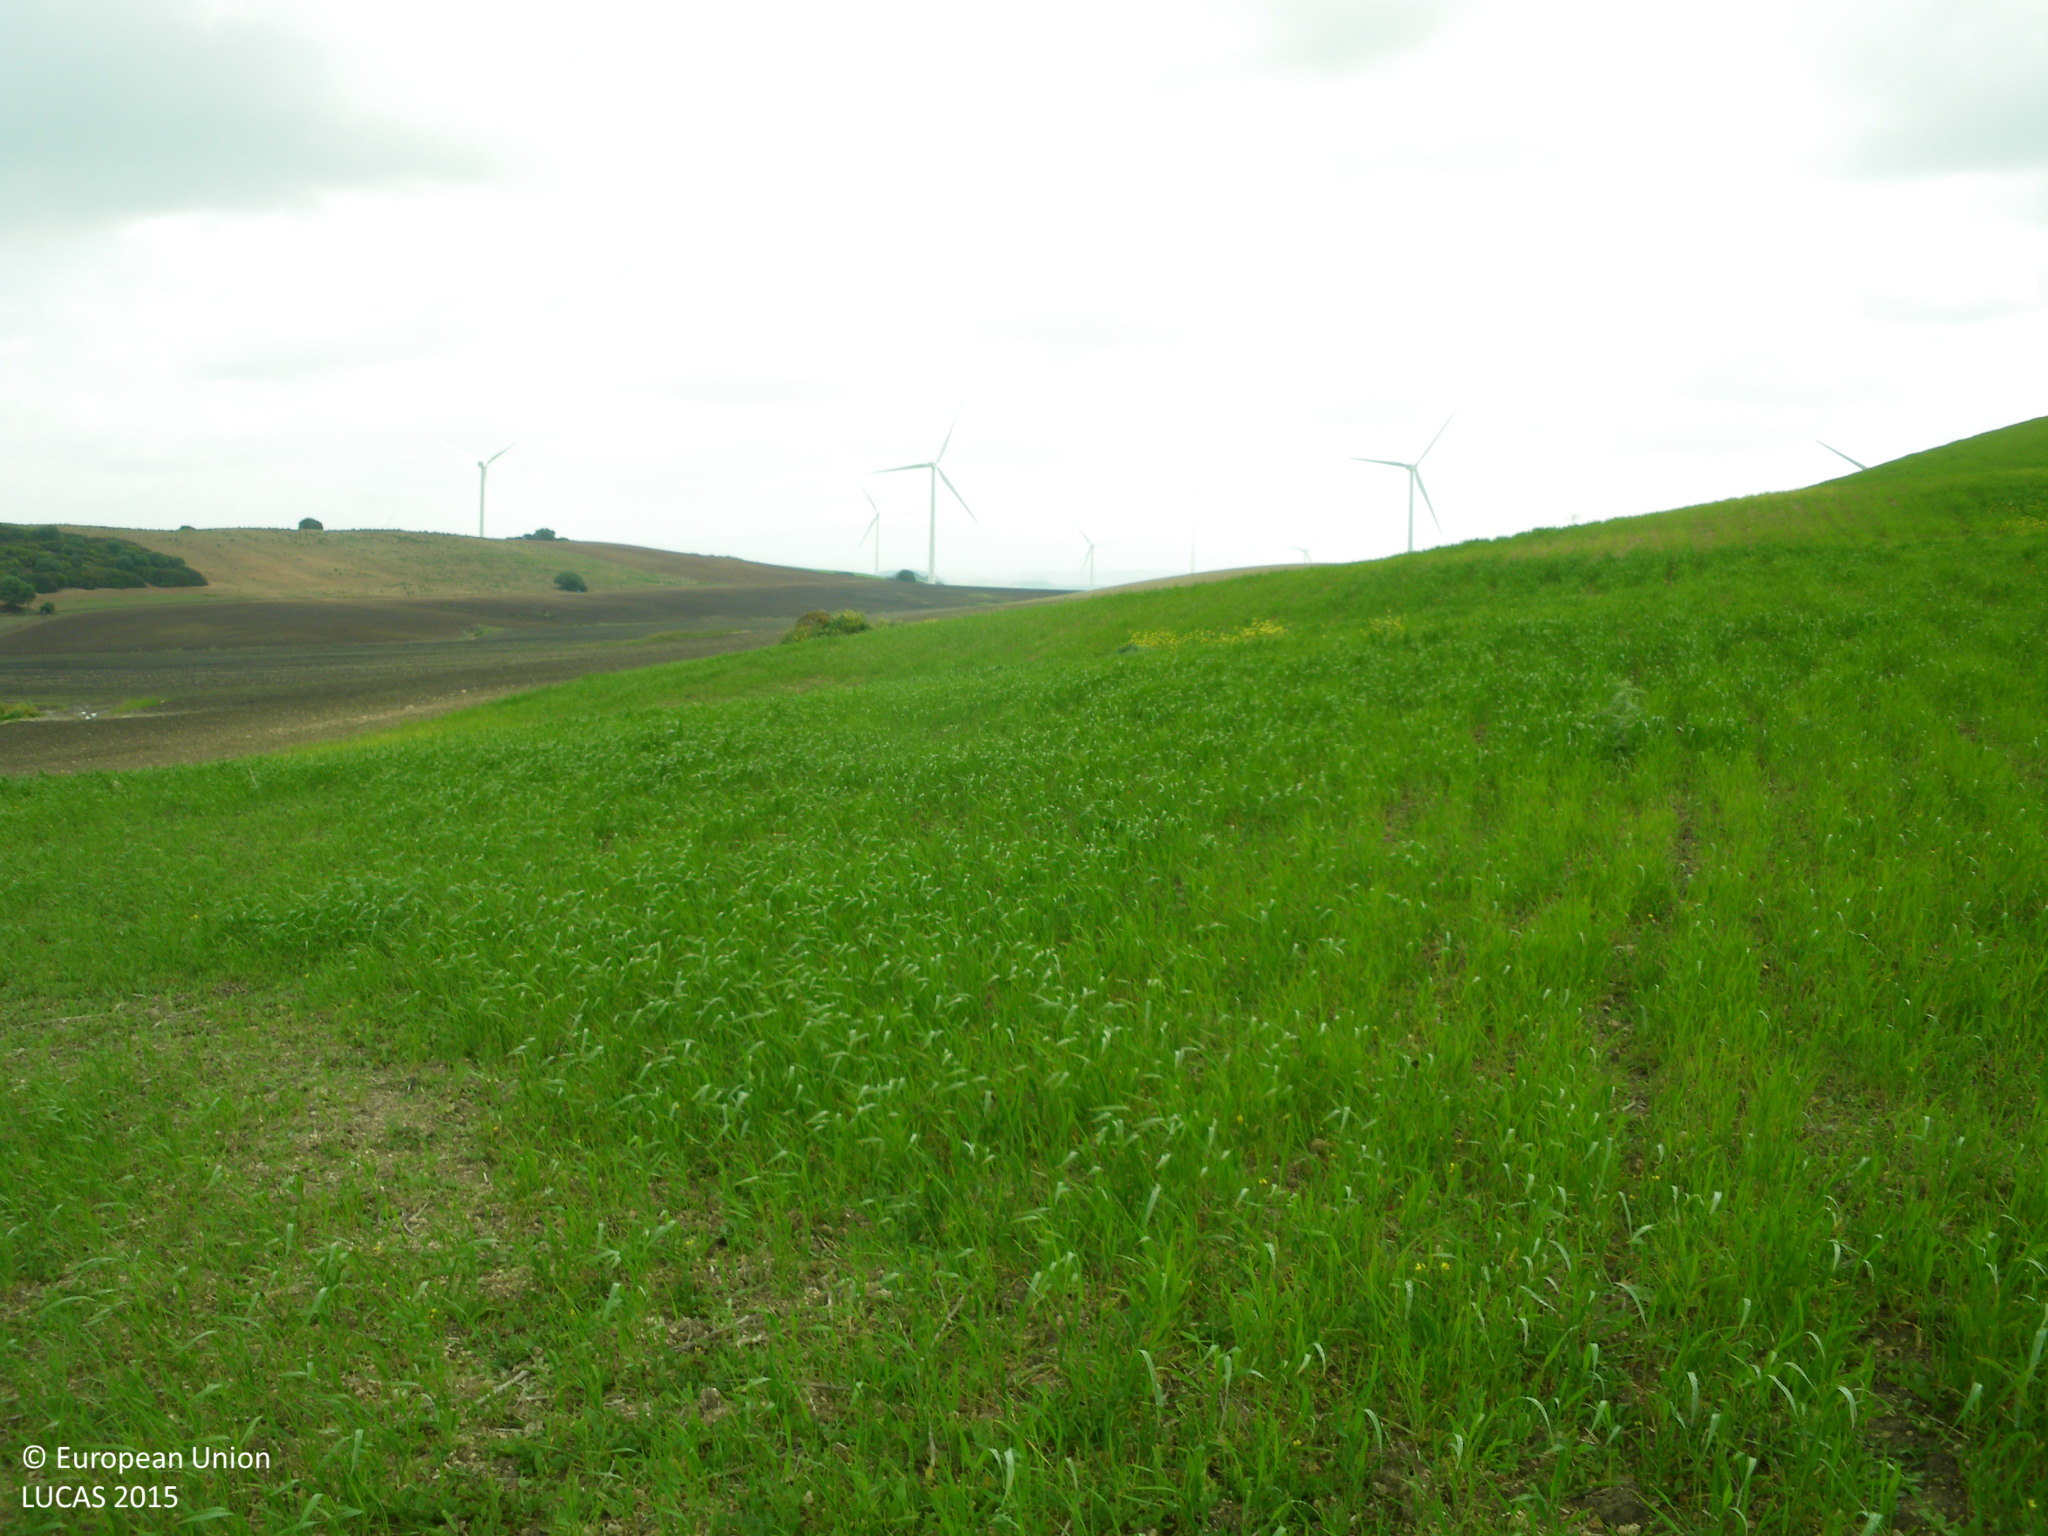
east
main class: Cropland
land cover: Durum wheat
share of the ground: > 75 %
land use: Agriculture (excluding fallow land and kitchen gardens)
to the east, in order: Durum wheat; Rock outcrops; Grassland without tree/shrub cover; Other structural elements; Grassland without tree/shrub cover; Sunflower
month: April
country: ES
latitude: 36.5186
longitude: -5.9639
